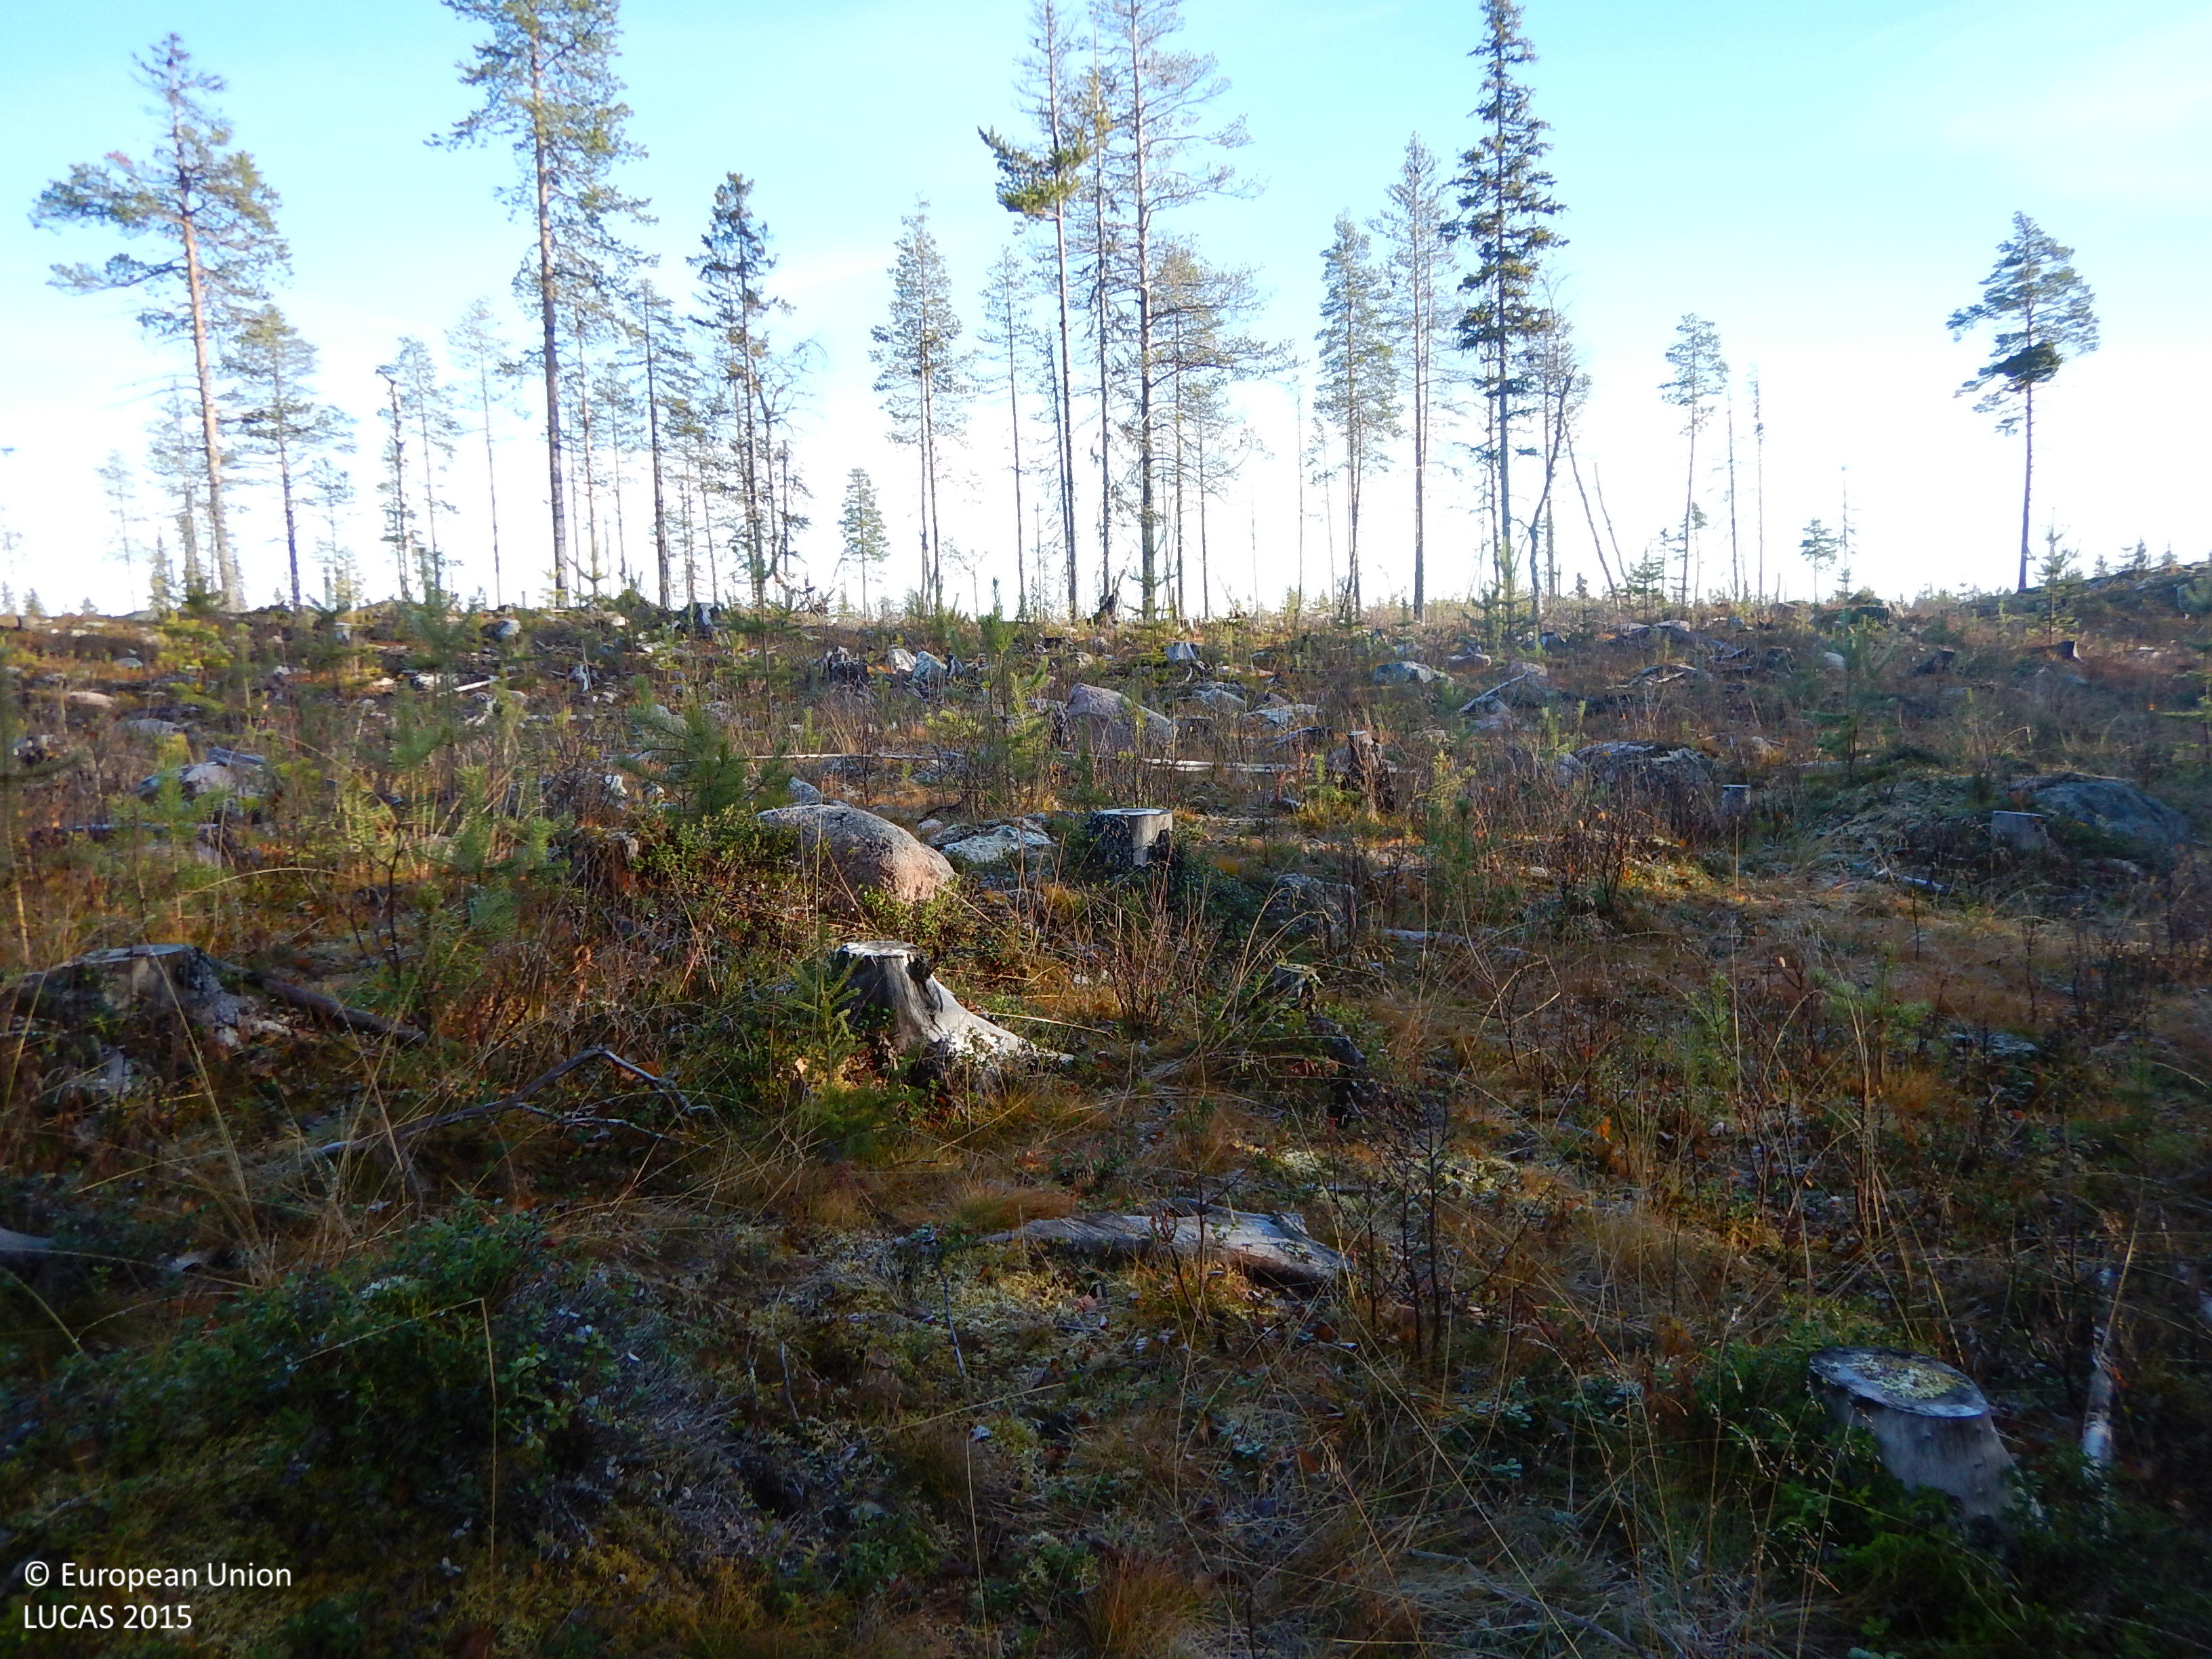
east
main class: Woodland
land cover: Pine dominated coniferous woodland
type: boreal forest
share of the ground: 10 - 25 %
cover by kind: herbaceous plants 40 %, shrubs 30 %, coniferous forest trees 15 %, lichens and mosses 15 %
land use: Forestry
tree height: < 5 m
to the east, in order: Pine dominated coniferous woodland; Peatbogs; Pine dominated coniferous woodland; Other mixed woodland
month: October
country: SE
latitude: 65.1213
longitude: 20.0020
